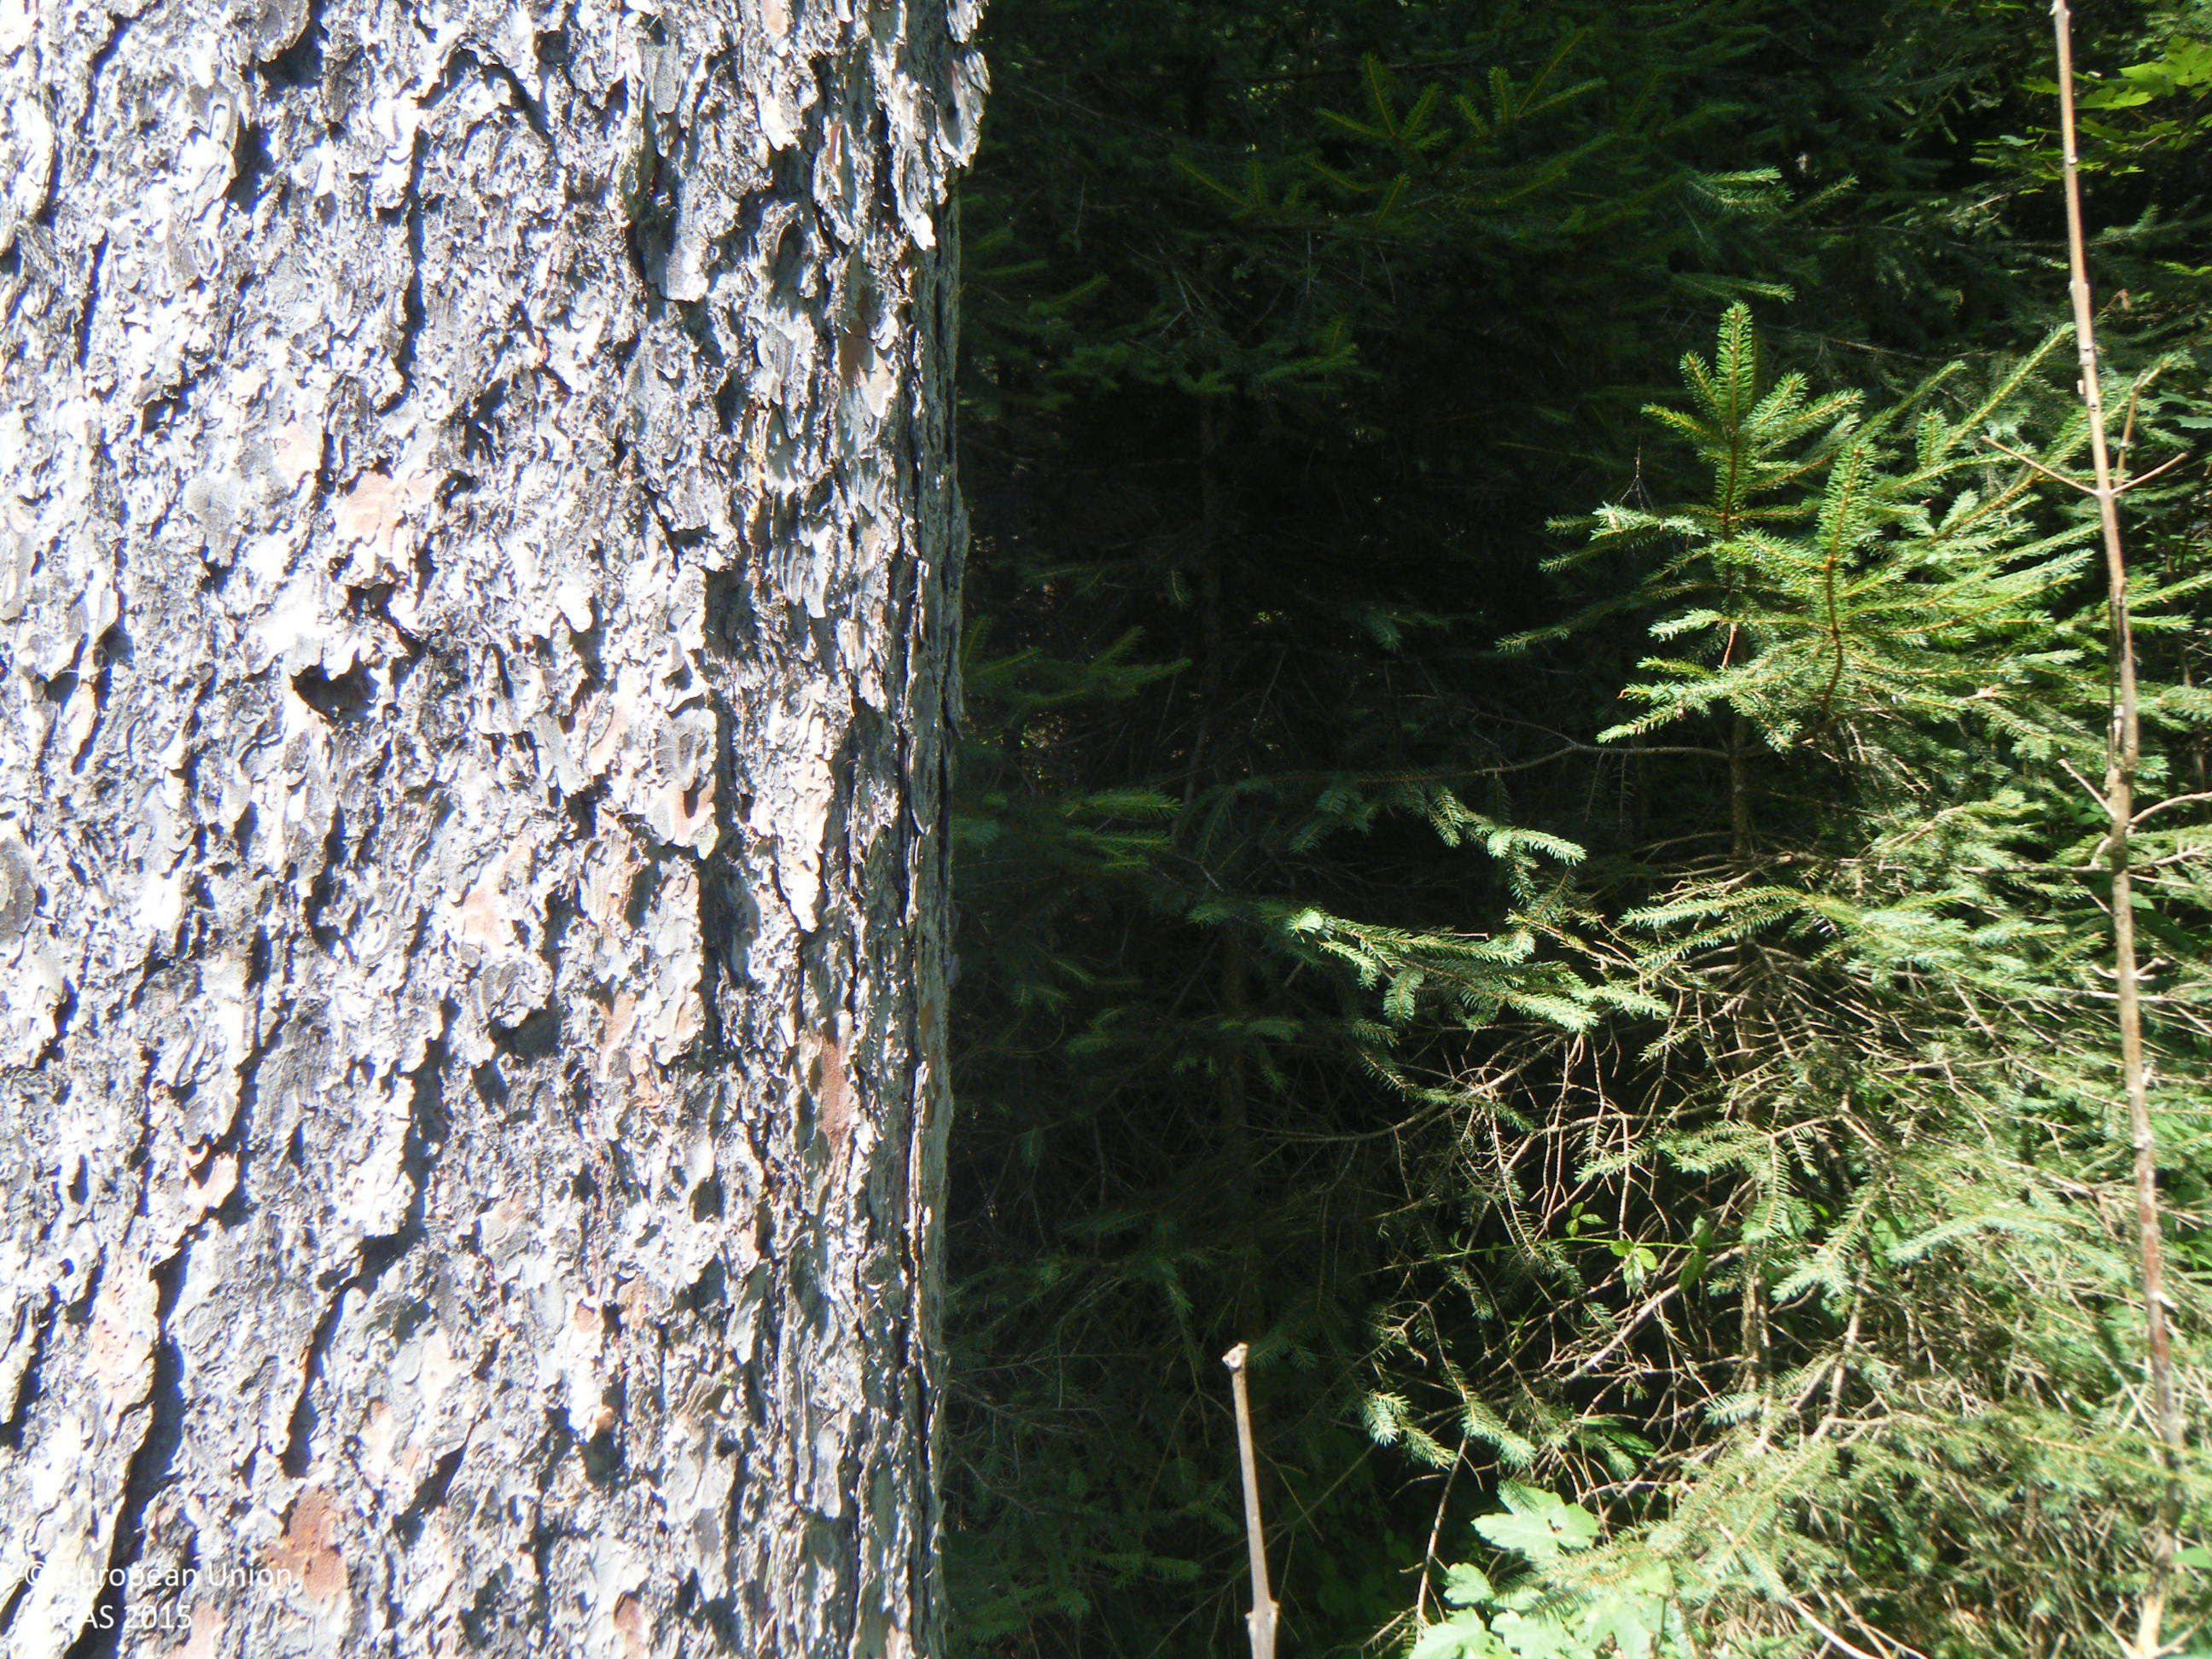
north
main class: Woodland
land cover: Other coniferous woodland
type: alpine coniferous forest
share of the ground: > 75 %
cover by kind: coniferous forest trees 70 %, broadleaved forest trees 20 %, shrubs 5 %, herbaceous plants 5 %
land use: Forestry
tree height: > 5 m
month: July
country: AT
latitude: 47.5900
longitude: 13.5491
